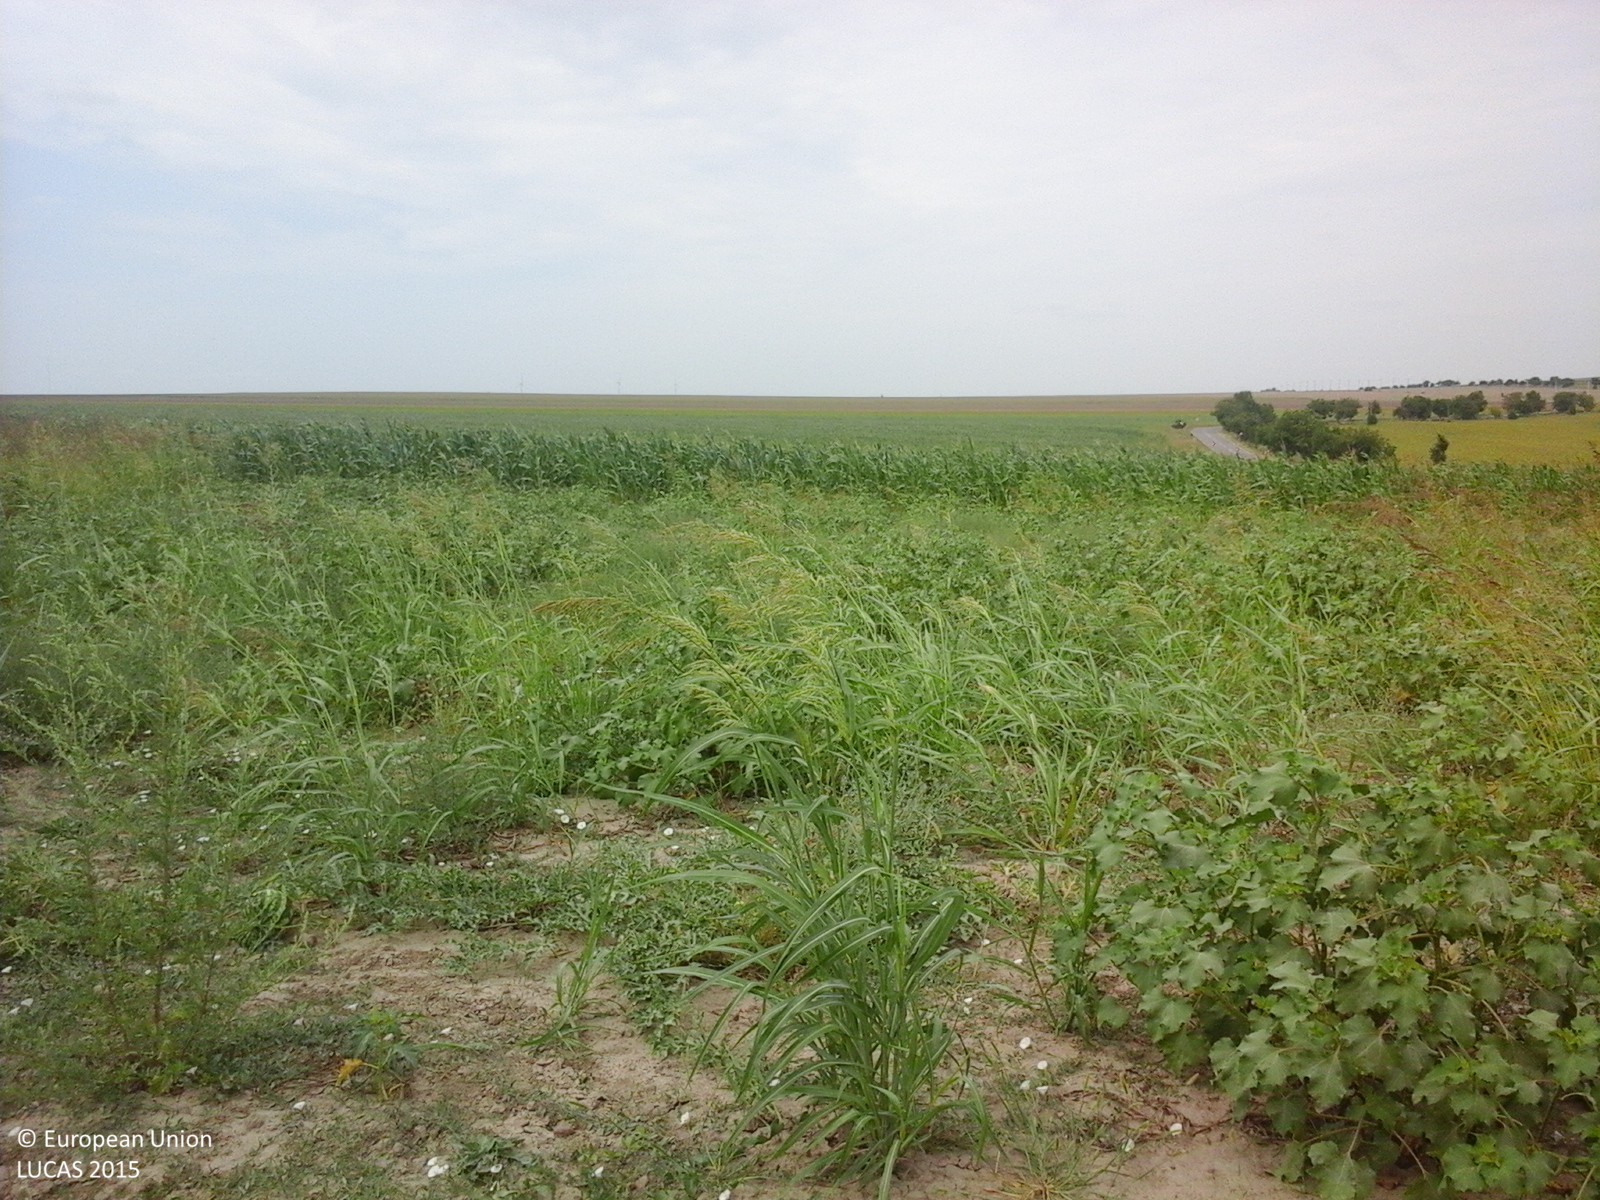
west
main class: Grassland
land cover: Spontaneously vegetated surfaces
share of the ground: > 75 %
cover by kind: herbaceous plants 100 %
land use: Fallow land
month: August
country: RO
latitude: 45.0733
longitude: 29.0886
